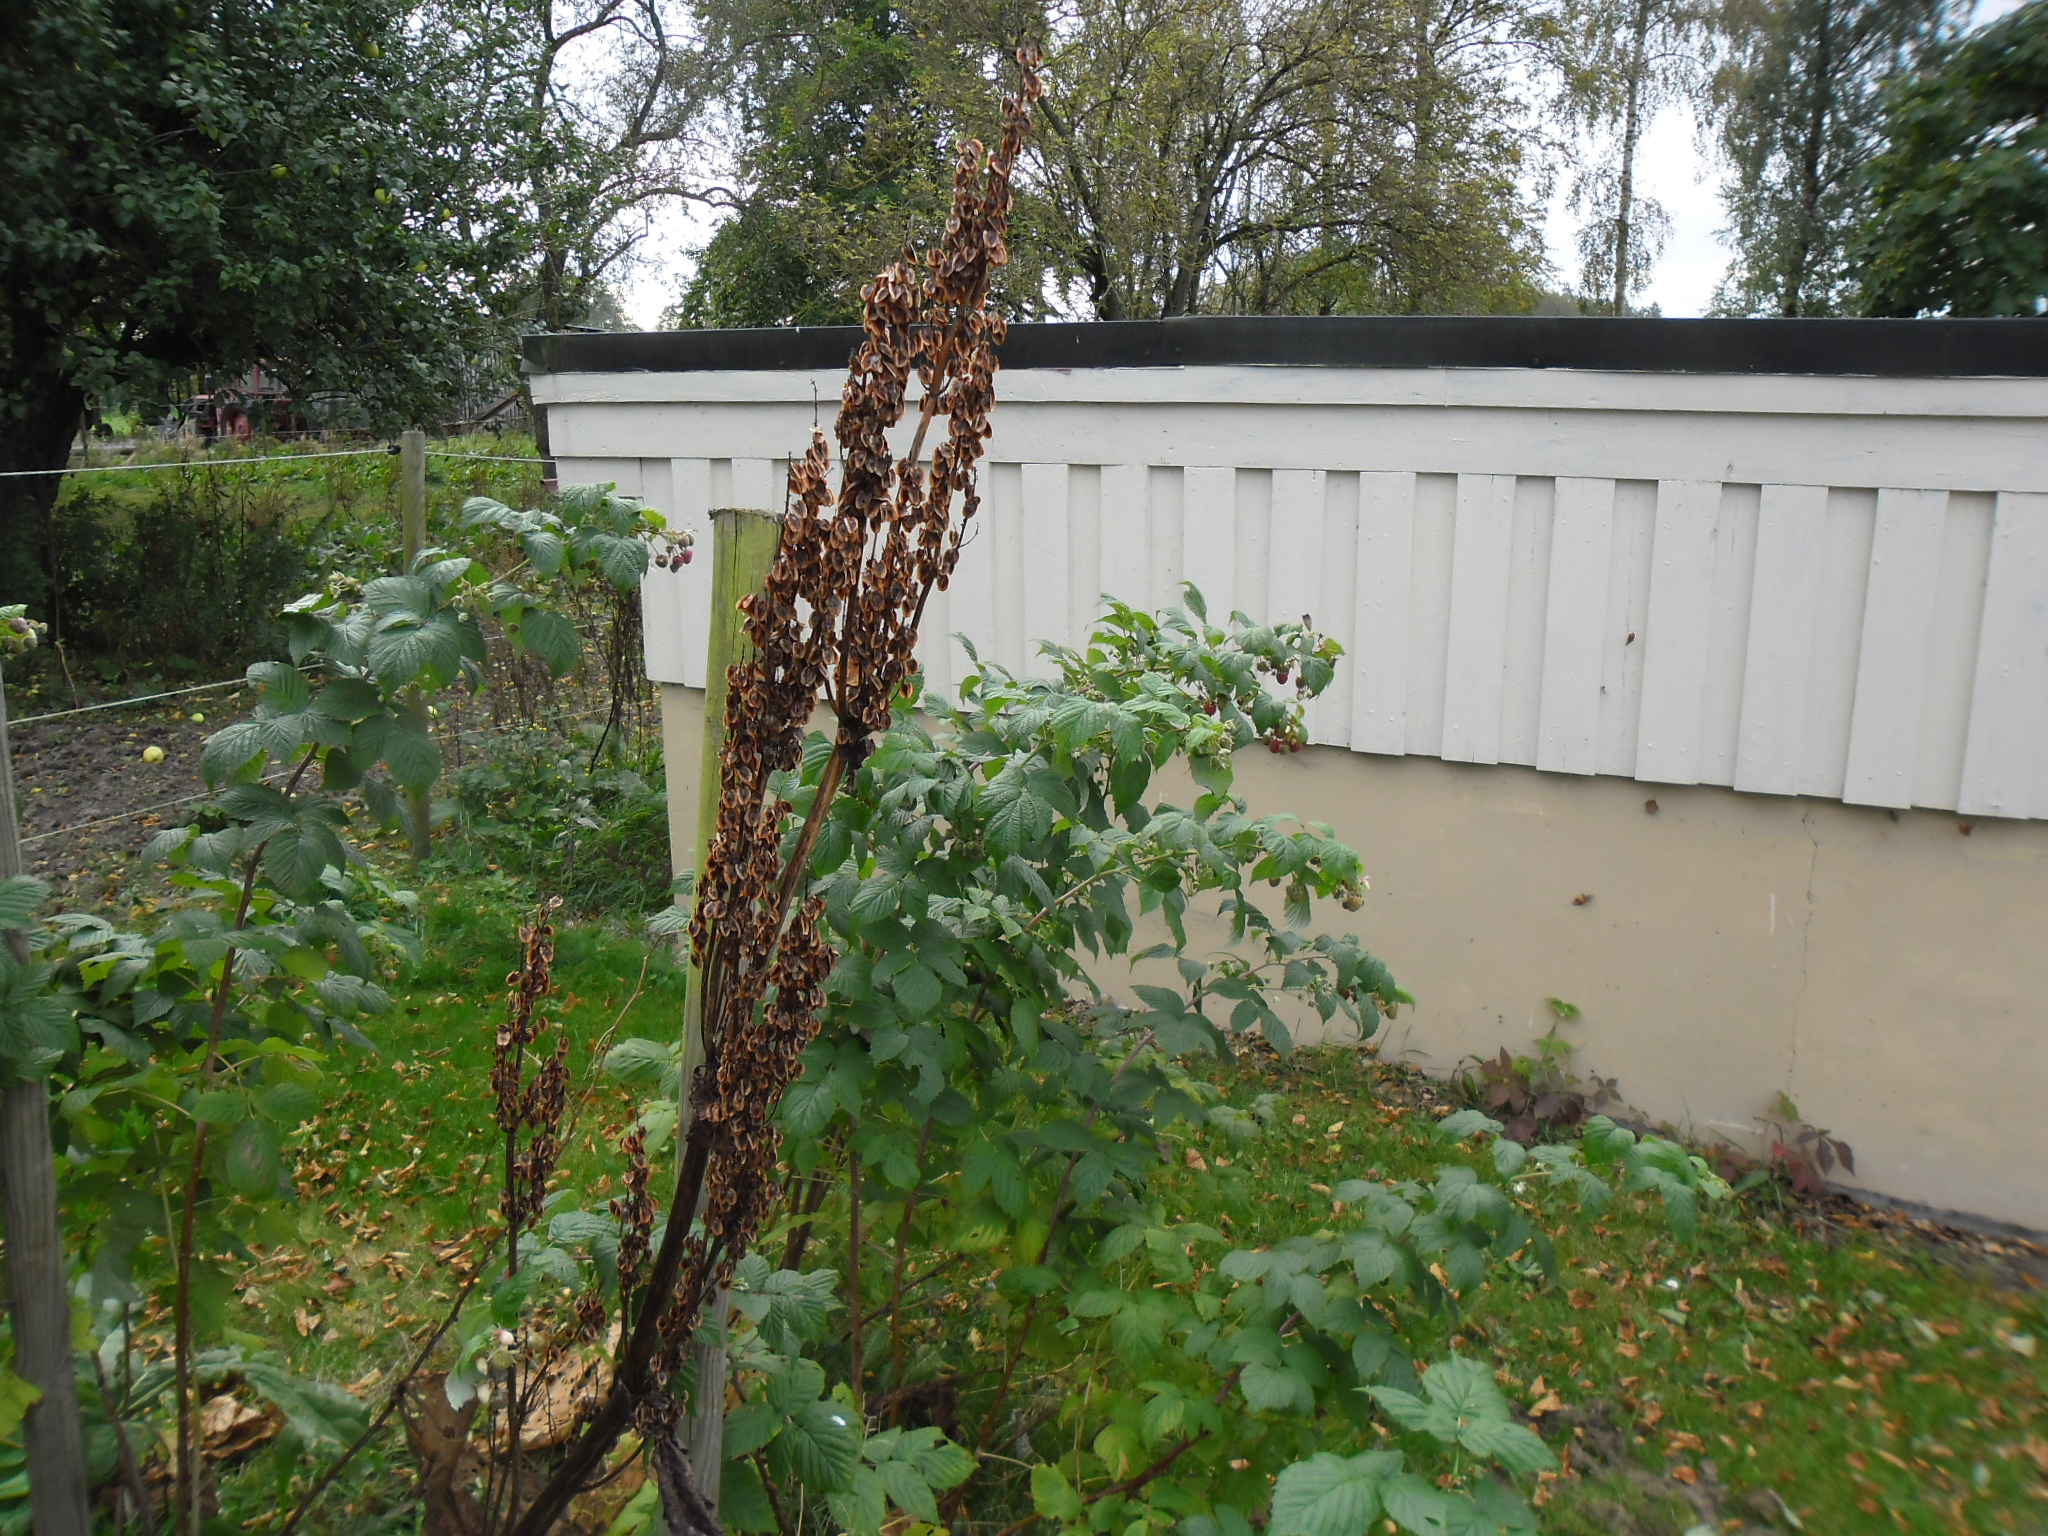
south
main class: Grassland
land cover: Grassland with sparse tree/shrub cover
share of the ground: > 75 %
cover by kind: herbaceous plants 95 %, broadleaved forest trees 5 %
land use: Residential
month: October
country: SE
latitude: 56.4914
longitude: 13.1317
